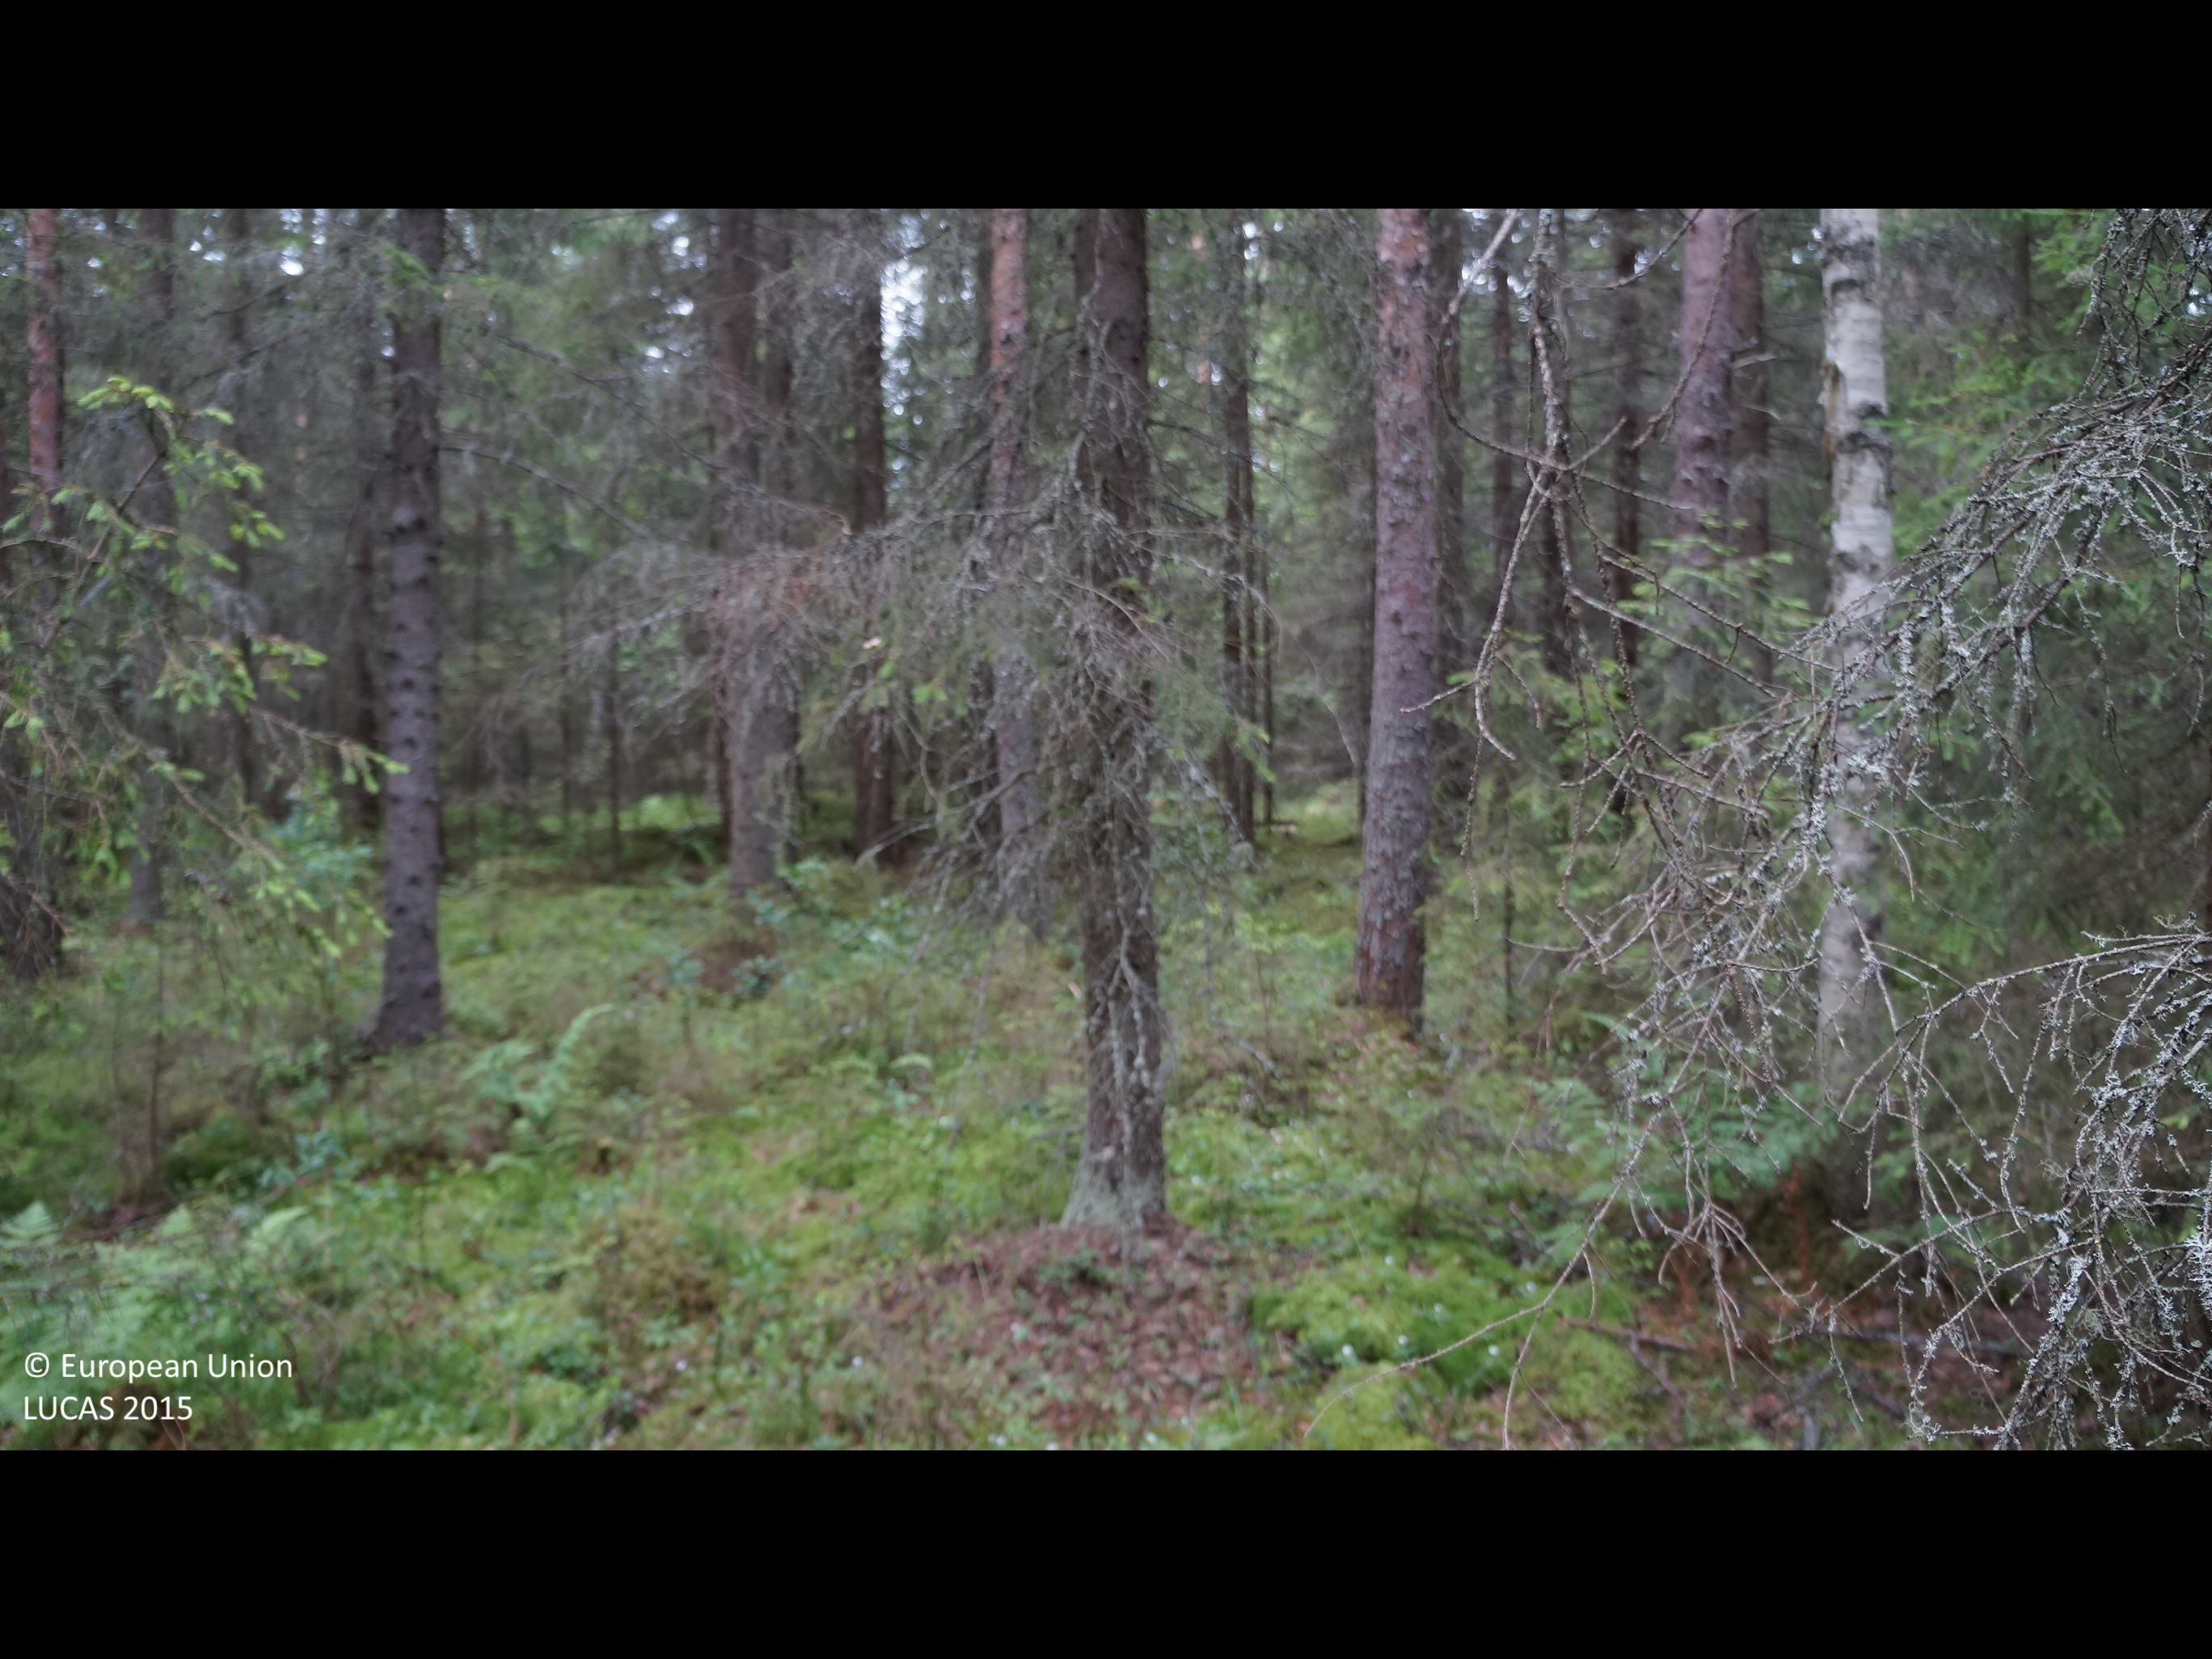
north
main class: Woodland
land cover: Spruce dominated mixed woodland
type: boreal forest
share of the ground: > 75 %
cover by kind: coniferous forest trees 45 %, broadleaved forest trees 30 %, shrubs 10 %, lichens and mosses 10 %, herbaceous plants 5 %
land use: Forestry
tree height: > 5 m
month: June
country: FI
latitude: 64.2137
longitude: 24.2215
